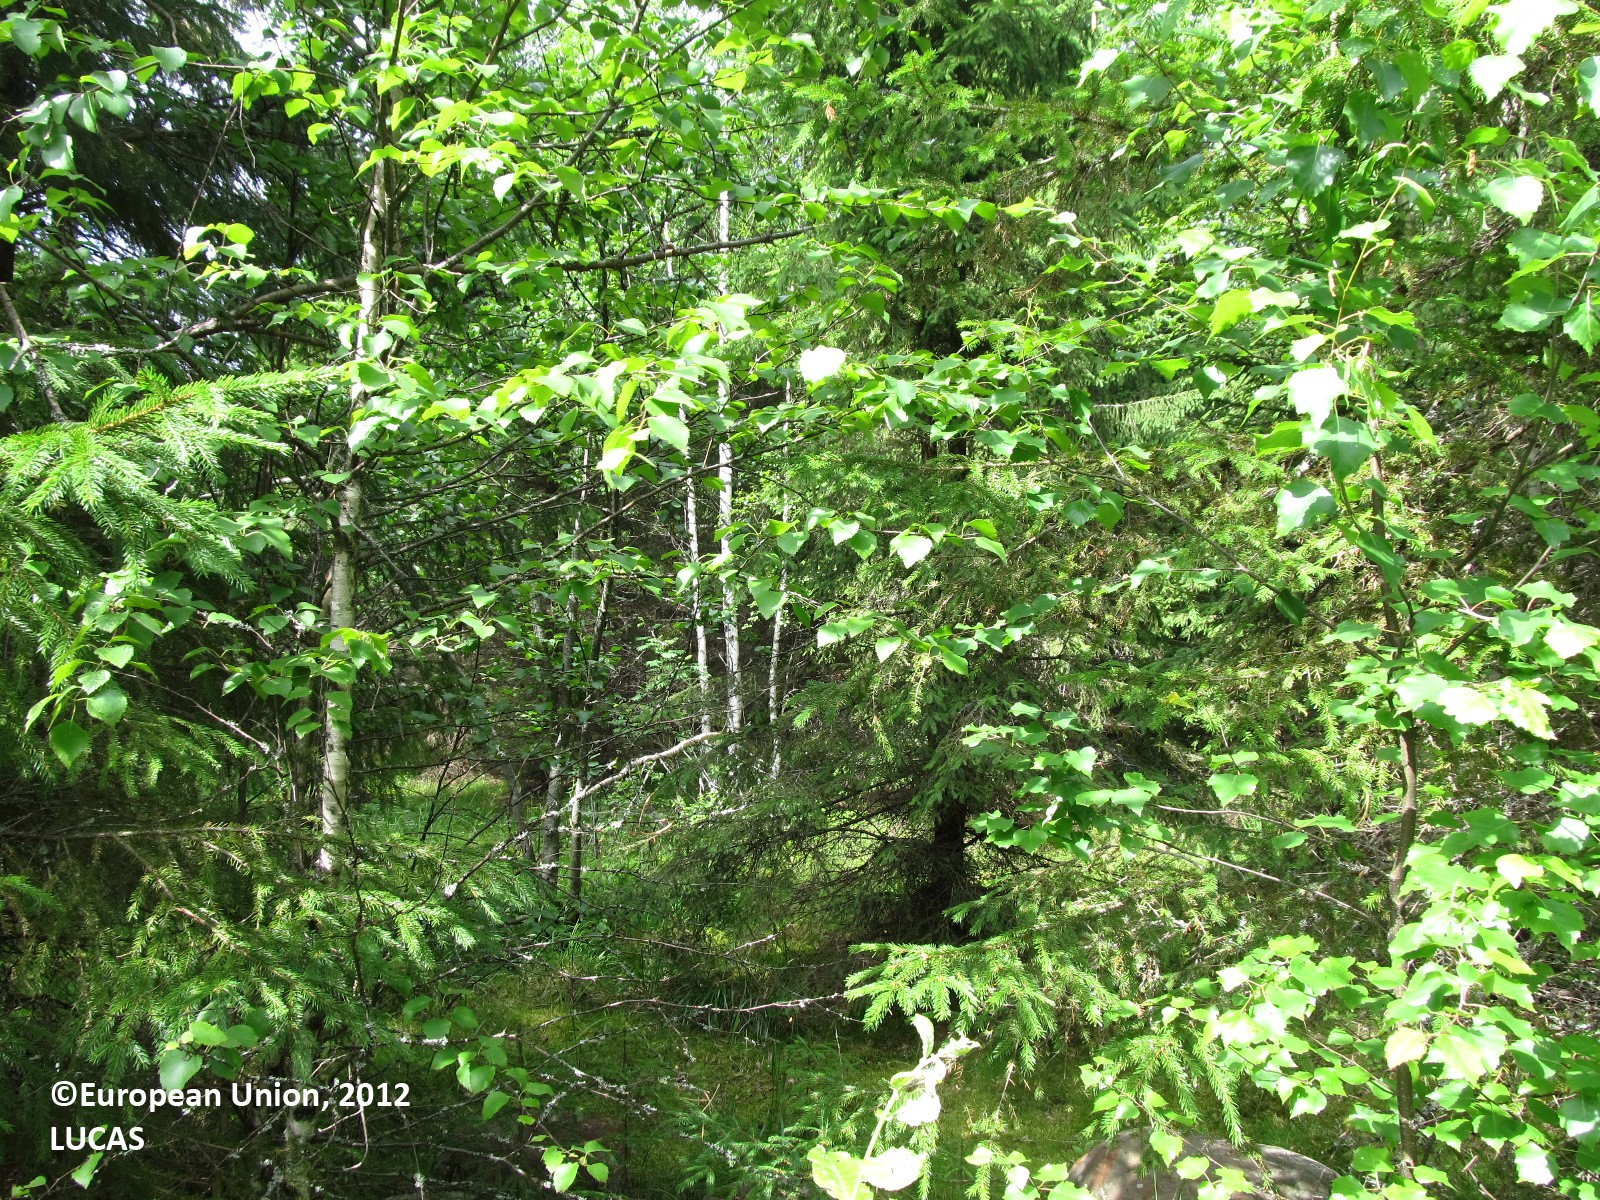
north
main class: Woodland
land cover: Spruce dominated mixed woodland
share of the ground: 25 - 50 %
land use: Forestry
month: July
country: FI
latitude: 62.0455
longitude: 28.7845
